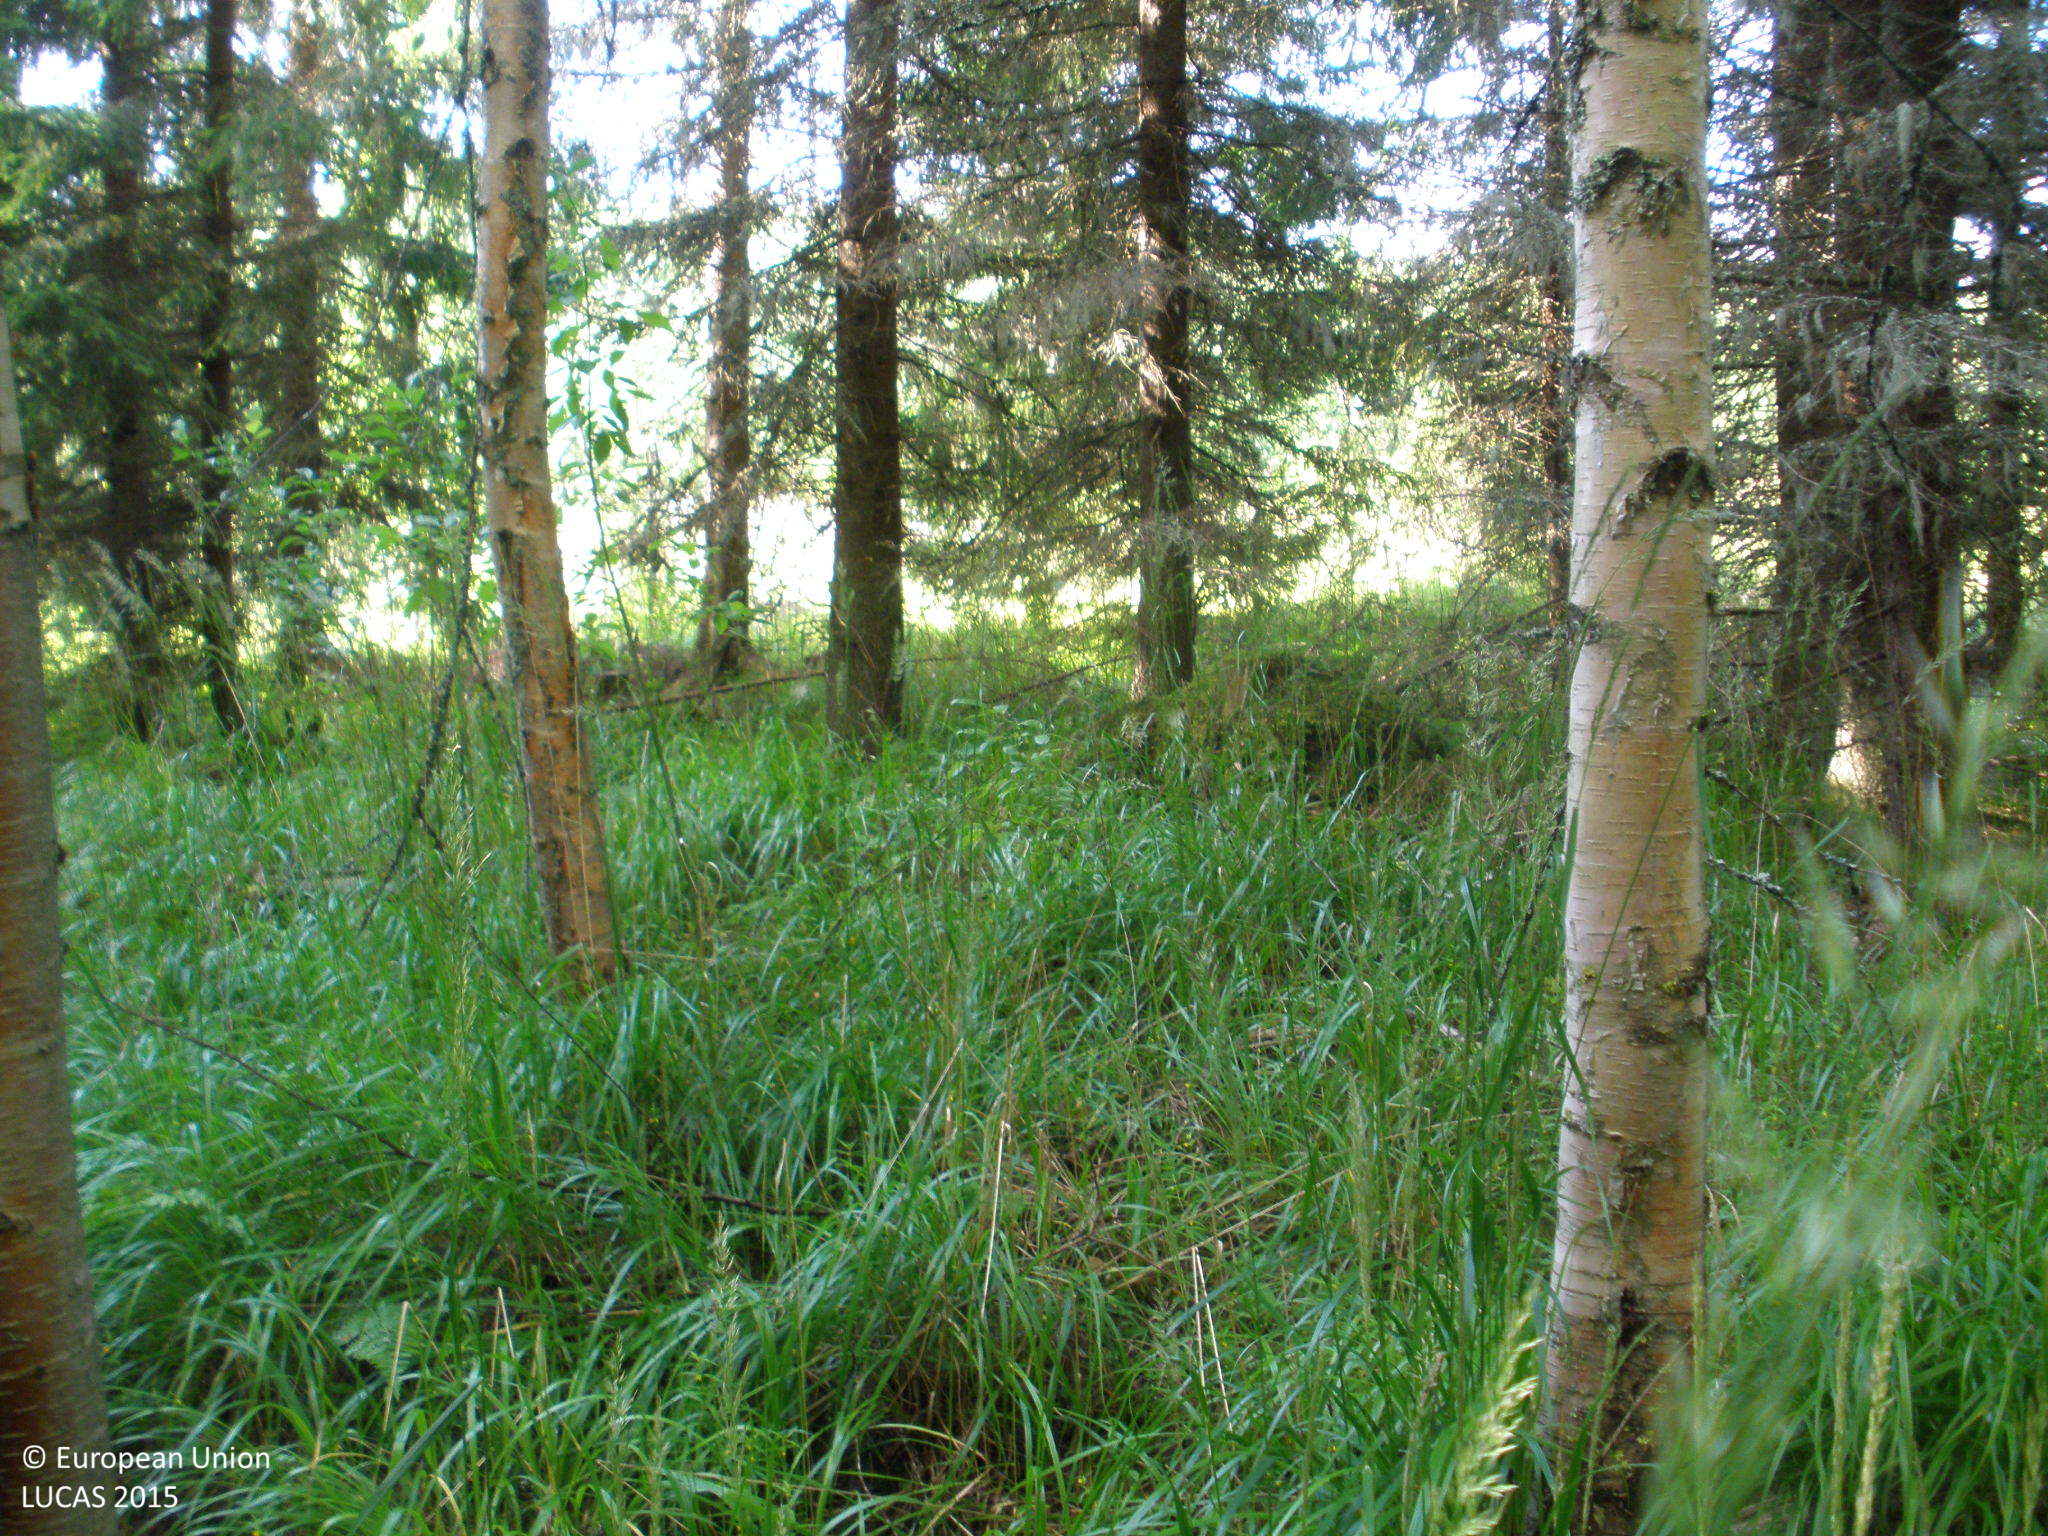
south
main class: Woodland
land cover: Spruce dominated mixed woodland
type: boreal forest
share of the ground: > 75 %
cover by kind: coniferous forest trees 55 %, broadleaved forest trees 30 %, herbaceous plants 10 %, shrubs 5 %
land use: Forestry
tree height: > 5 m
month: July
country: FI
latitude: 60.9826
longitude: 25.0661
